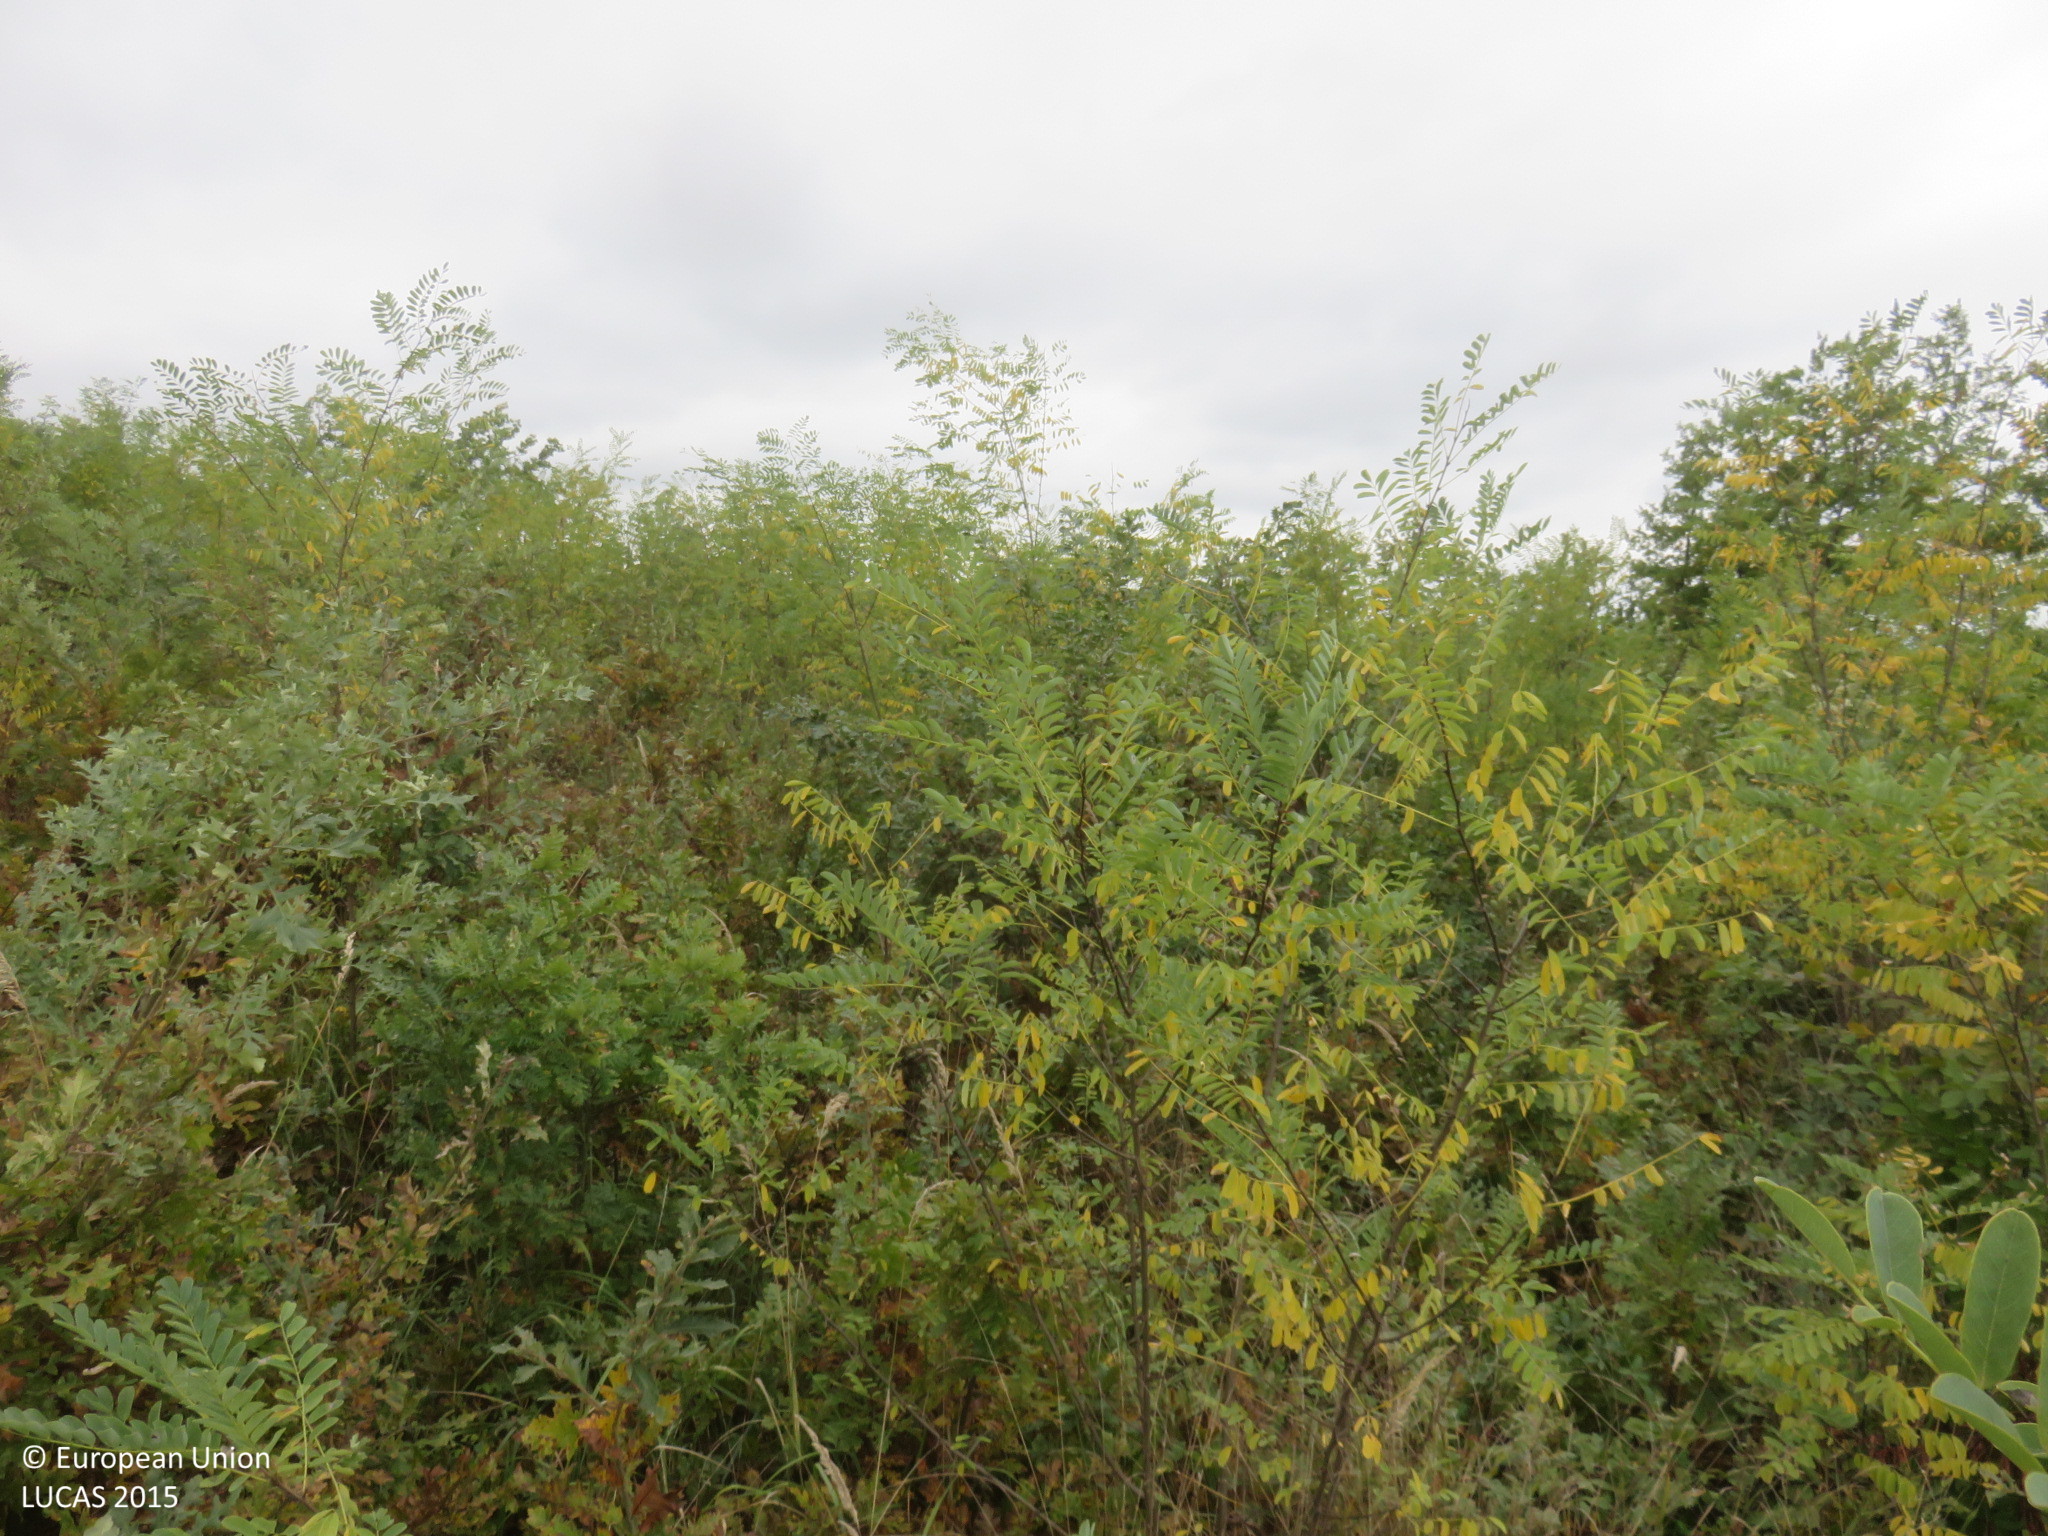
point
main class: Woodland
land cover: Broadleaved woodland
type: mesophytic deciduous forest
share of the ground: > 75 %
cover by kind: shrubs 75 %, broadleaved forest trees 25 %
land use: Forestry
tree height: < 5 m
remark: Clear cut
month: October
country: BG
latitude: 43.0037
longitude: 25.1956
